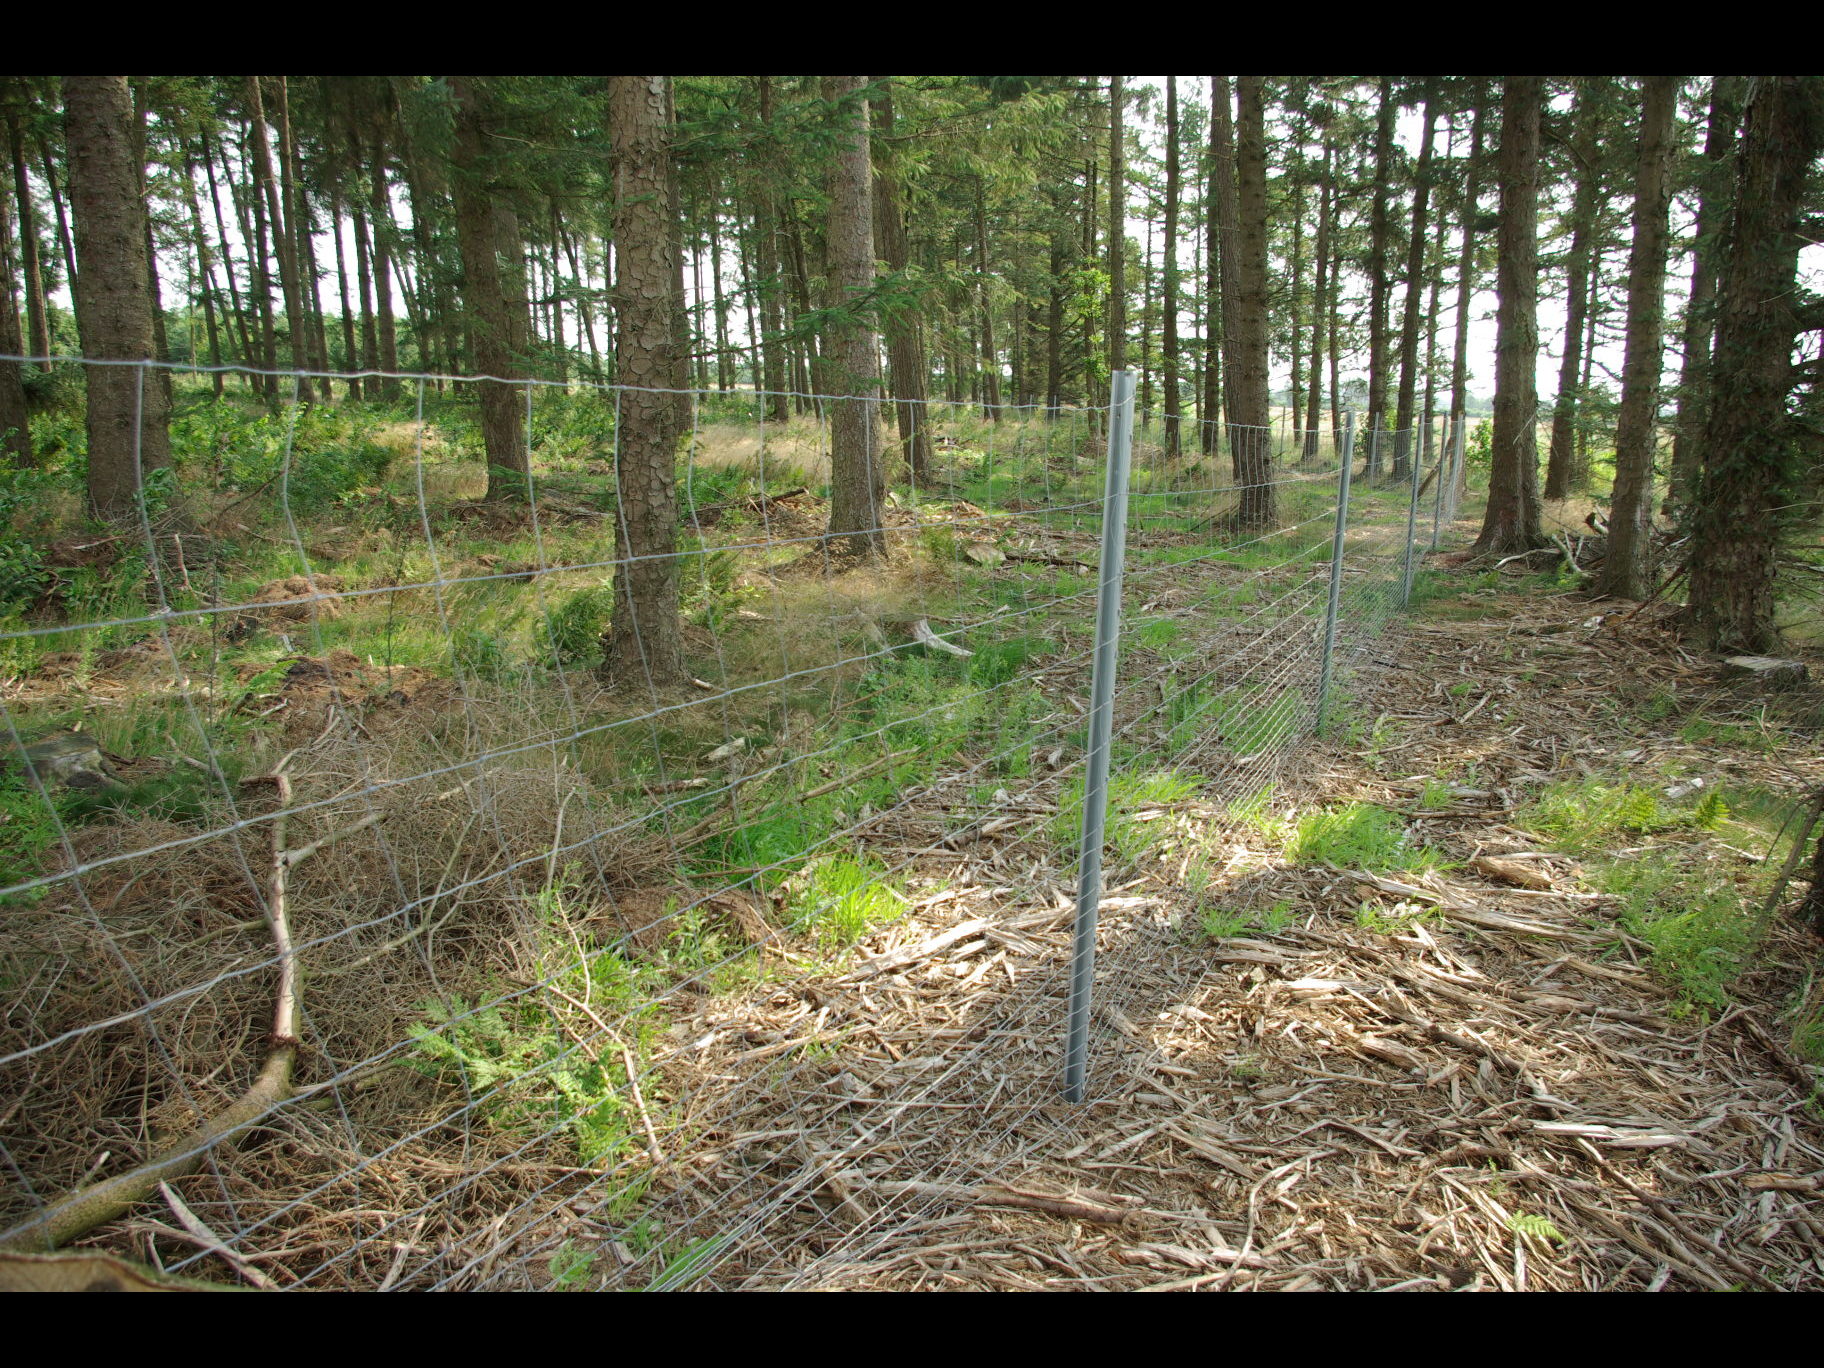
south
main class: Woodland
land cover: Spruce dominated coniferous woodland
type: hemiboreal forest and nemoral coniferous forest and mixed broadleaved-coniferous forest
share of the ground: 50 - 75 %
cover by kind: coniferous forest trees 60 %, herbaceous plants 30 %, unconsolidated bare surface 10 %
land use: Forestry
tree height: > 5 m
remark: Clear cut
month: August
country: DE
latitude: 54.5502
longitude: 9.3048
